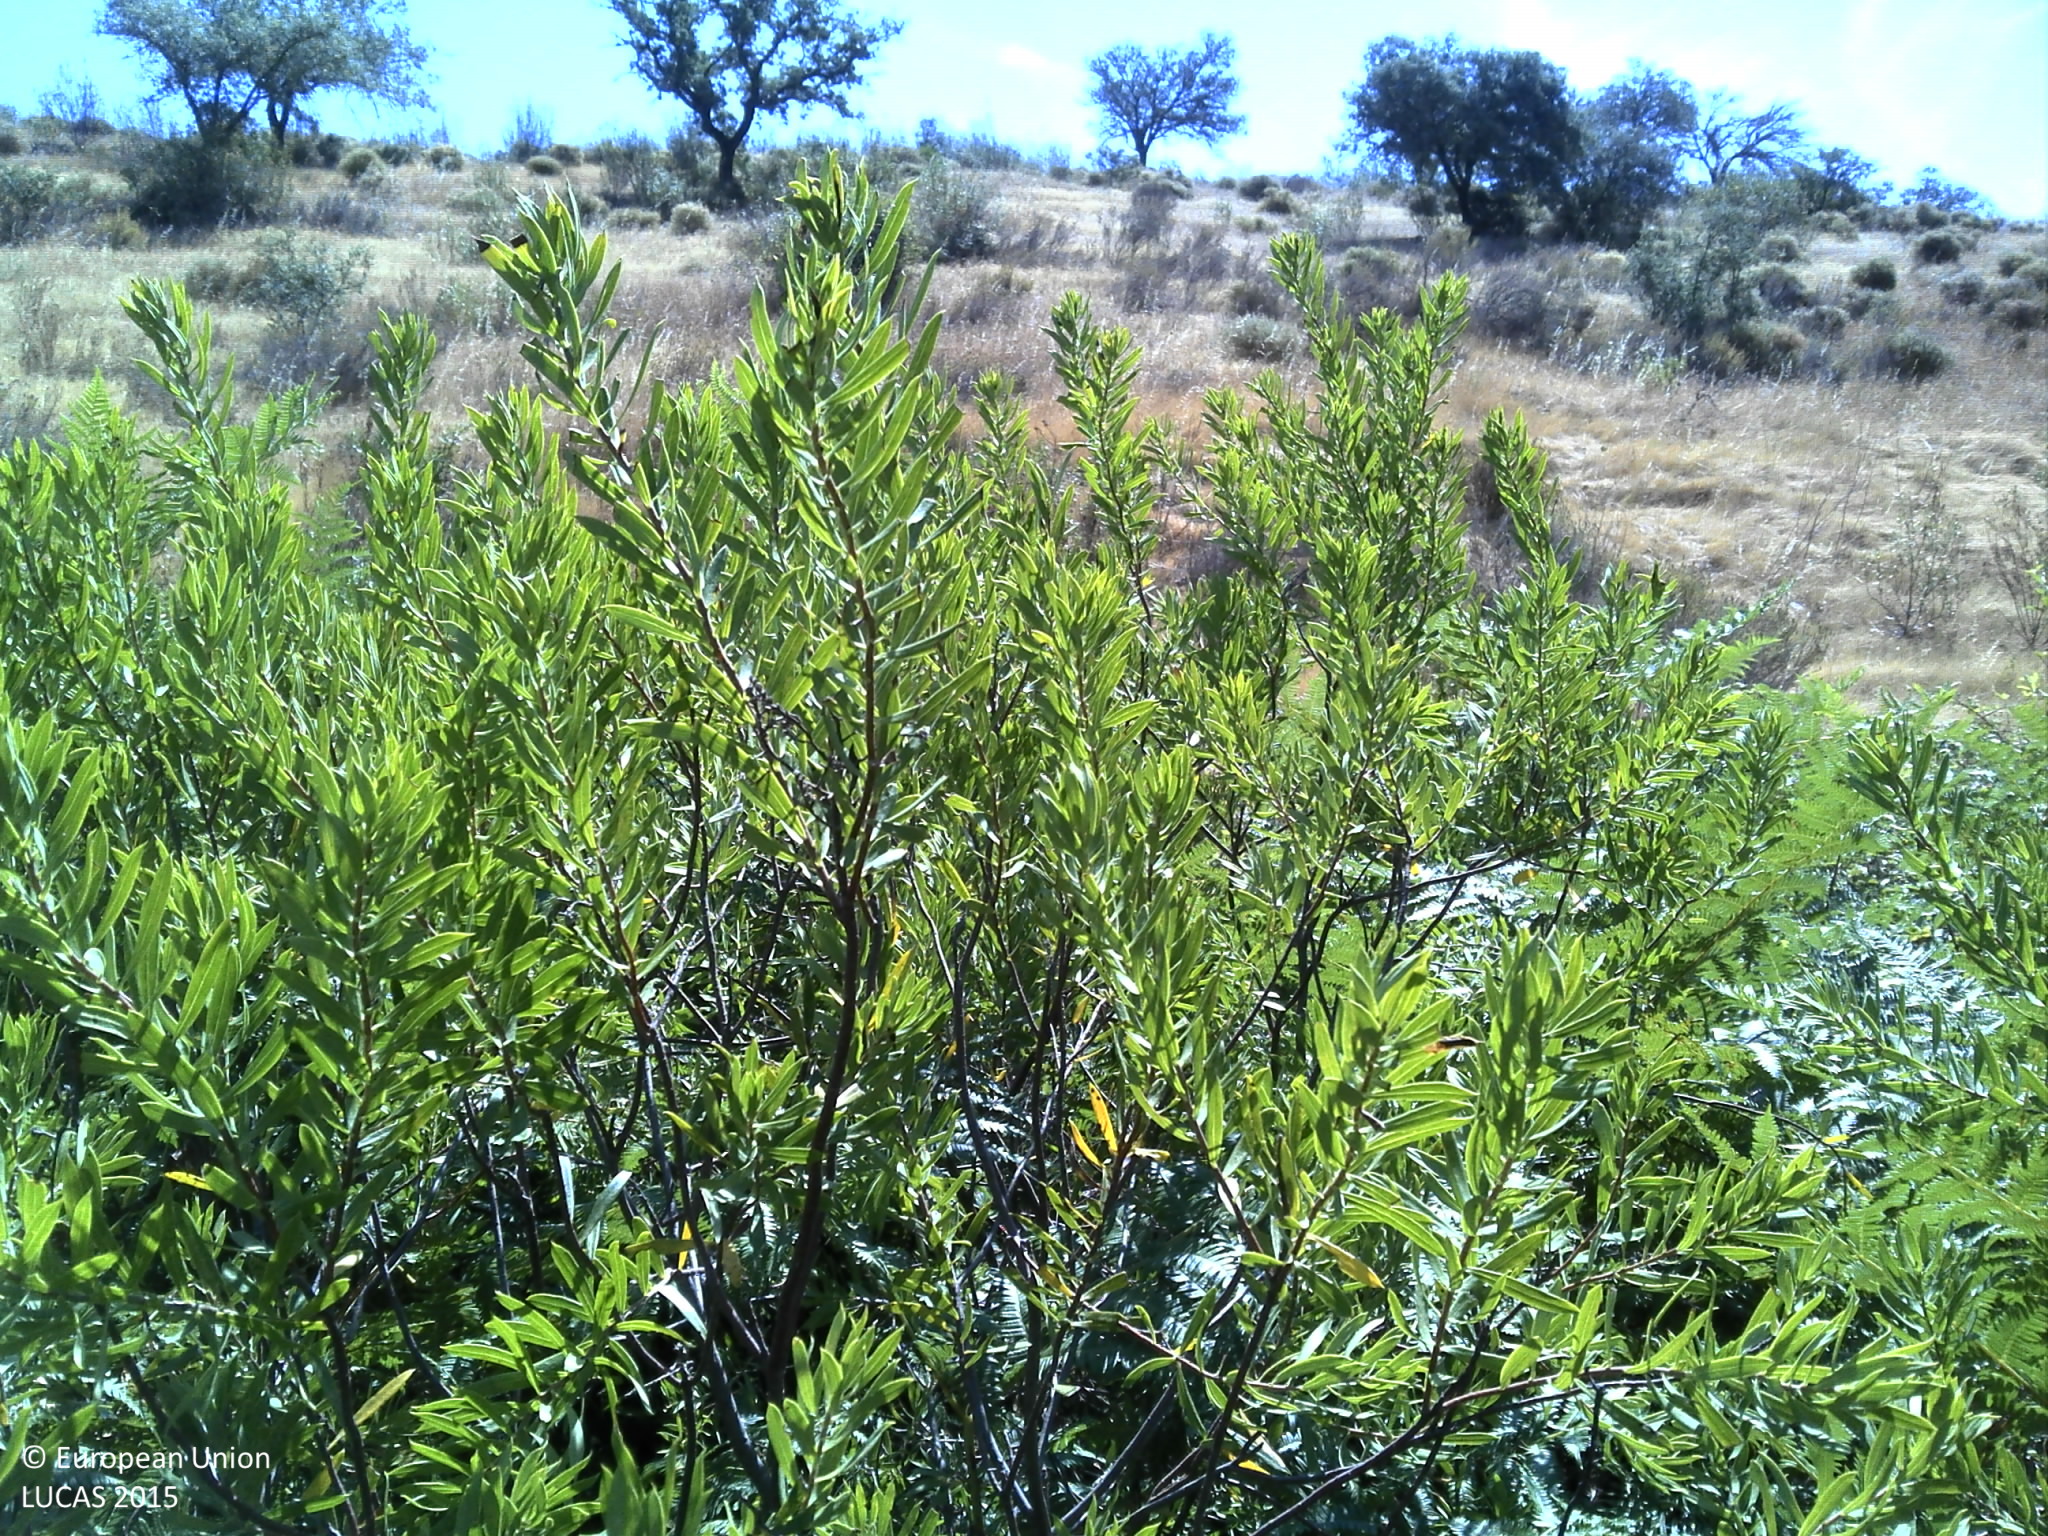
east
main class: Grassland
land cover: Spontaneously vegetated surfaces
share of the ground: > 75 %
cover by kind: herbaceous plants 95 %, shrubs 5 %
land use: Forestry
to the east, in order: Spontaneously vegetated surfaces; Rivers and streams; Shruby margins; Grassland without tree/shrub cover; Grassland with sparse tree/shrub cover; Shrubland with sparse tree cover; Fences; Shrubland with sparse tree cover; Tracks; Shrubland with sparse tree cover
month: June
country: PT
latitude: 37.8616
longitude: -7.5331
